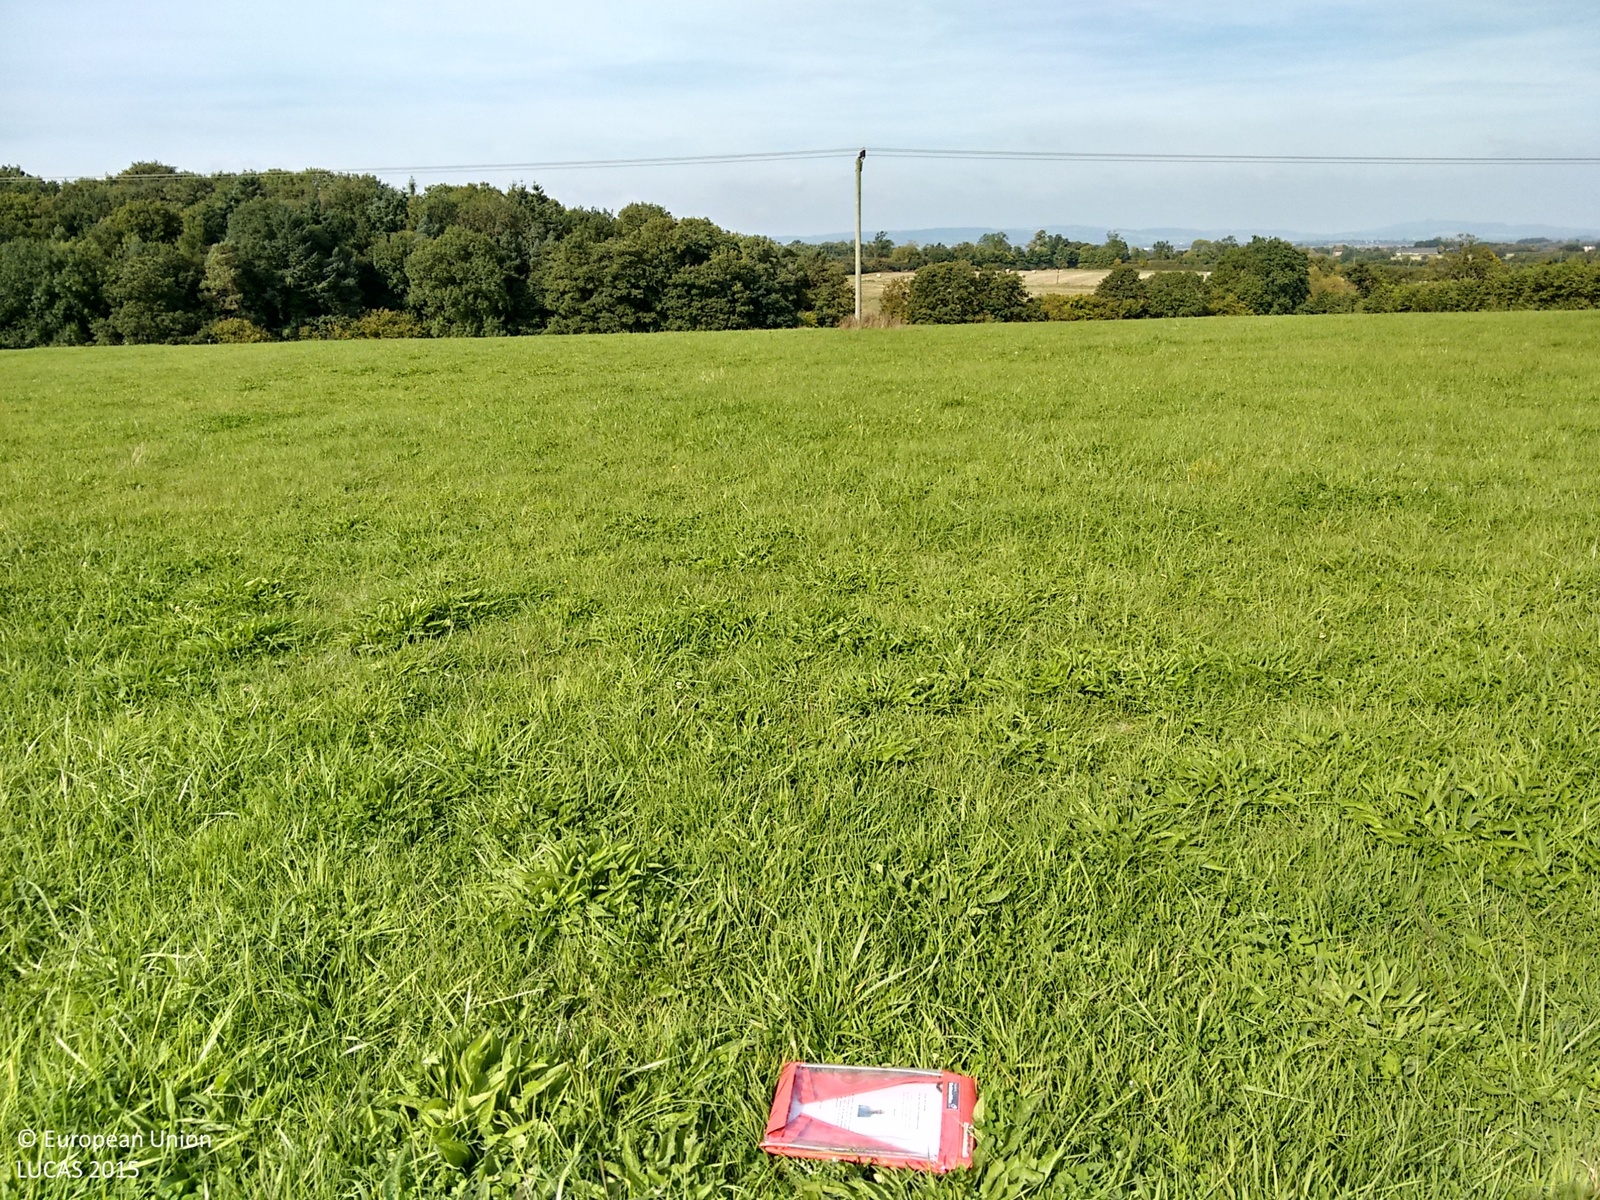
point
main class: Grassland
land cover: Grassland without tree/shrub cover
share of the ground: > 75 %
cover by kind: herbaceous plants 100 %
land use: Agriculture (excluding fallow land and kitchen gardens)
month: September
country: GB
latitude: 51.7051
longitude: -2.4085
